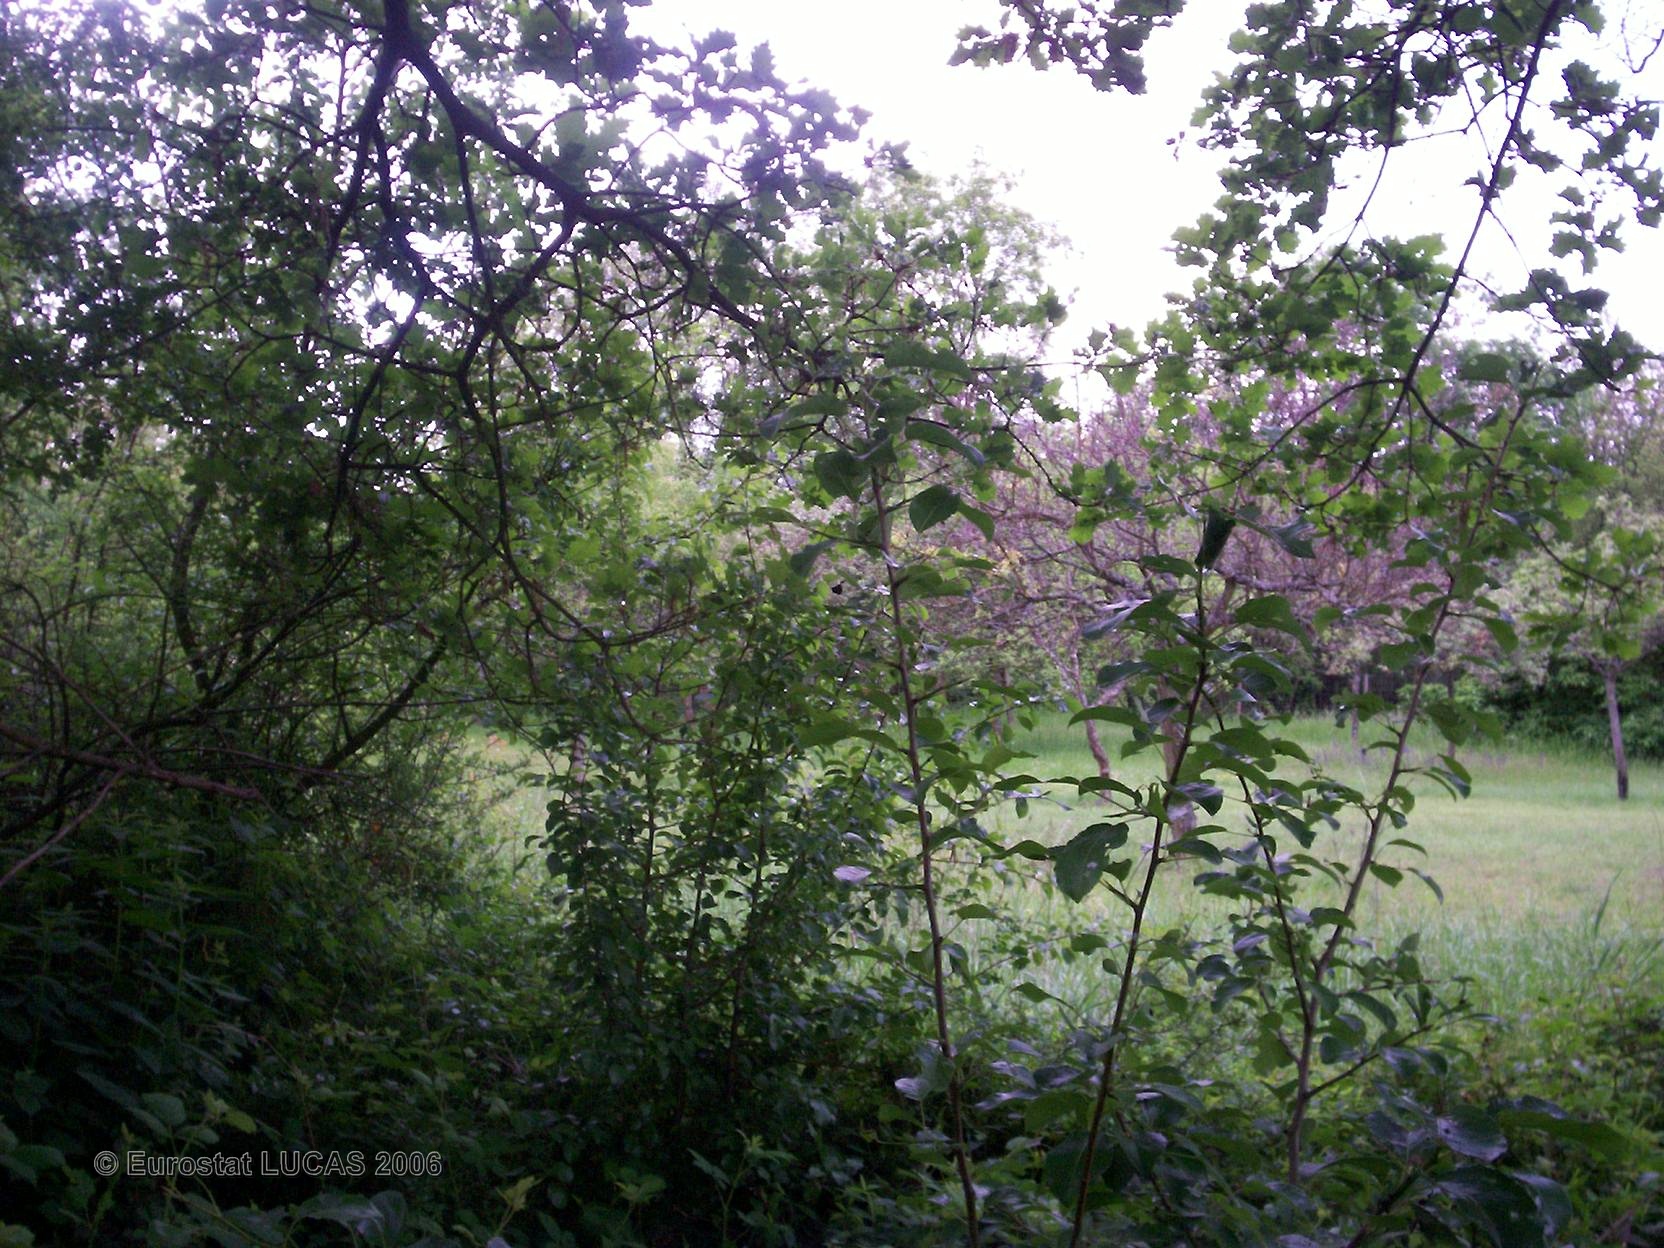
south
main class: Grassland
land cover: Grassland with sparse tree/shrub cover
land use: Residential
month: May
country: FR
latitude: 45.8067
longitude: 4.7404
